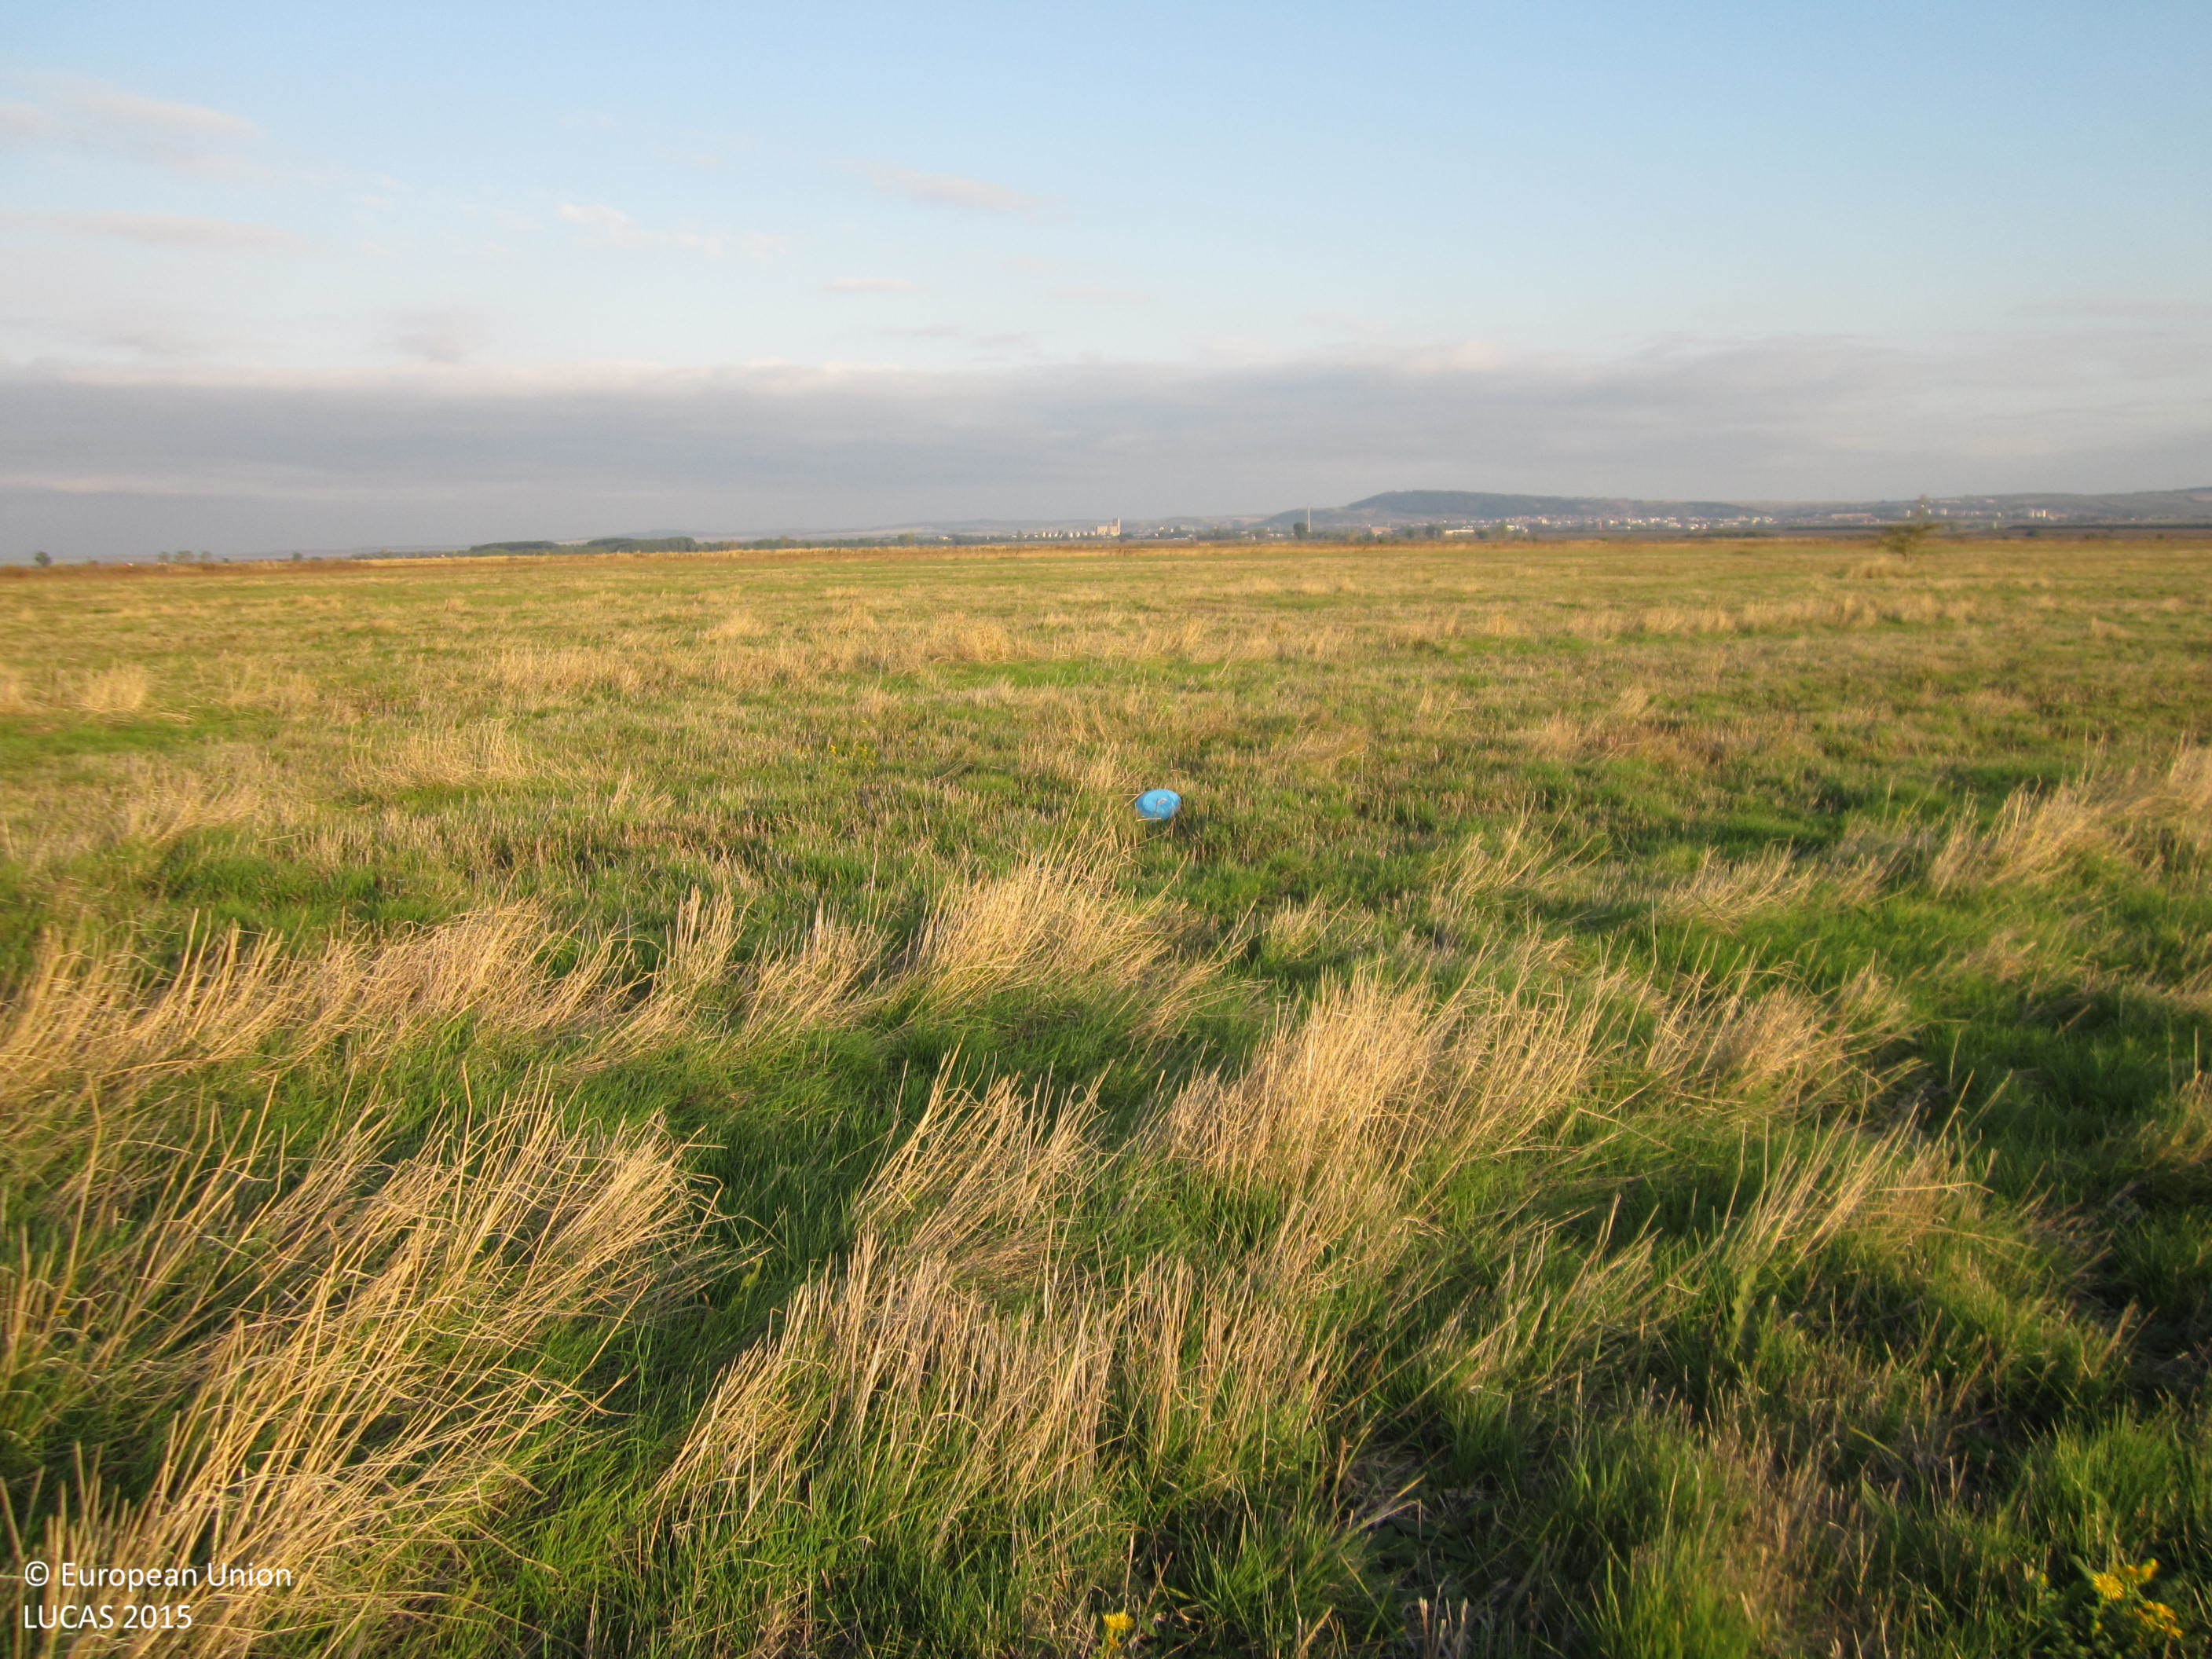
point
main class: Grassland
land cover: Grassland without tree/shrub cover
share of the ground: > 75 %
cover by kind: herbaceous plants 100 %
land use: Agriculture (excluding fallow land and kitchen gardens)
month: October
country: BG
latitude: 42.6883
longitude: 26.9365
